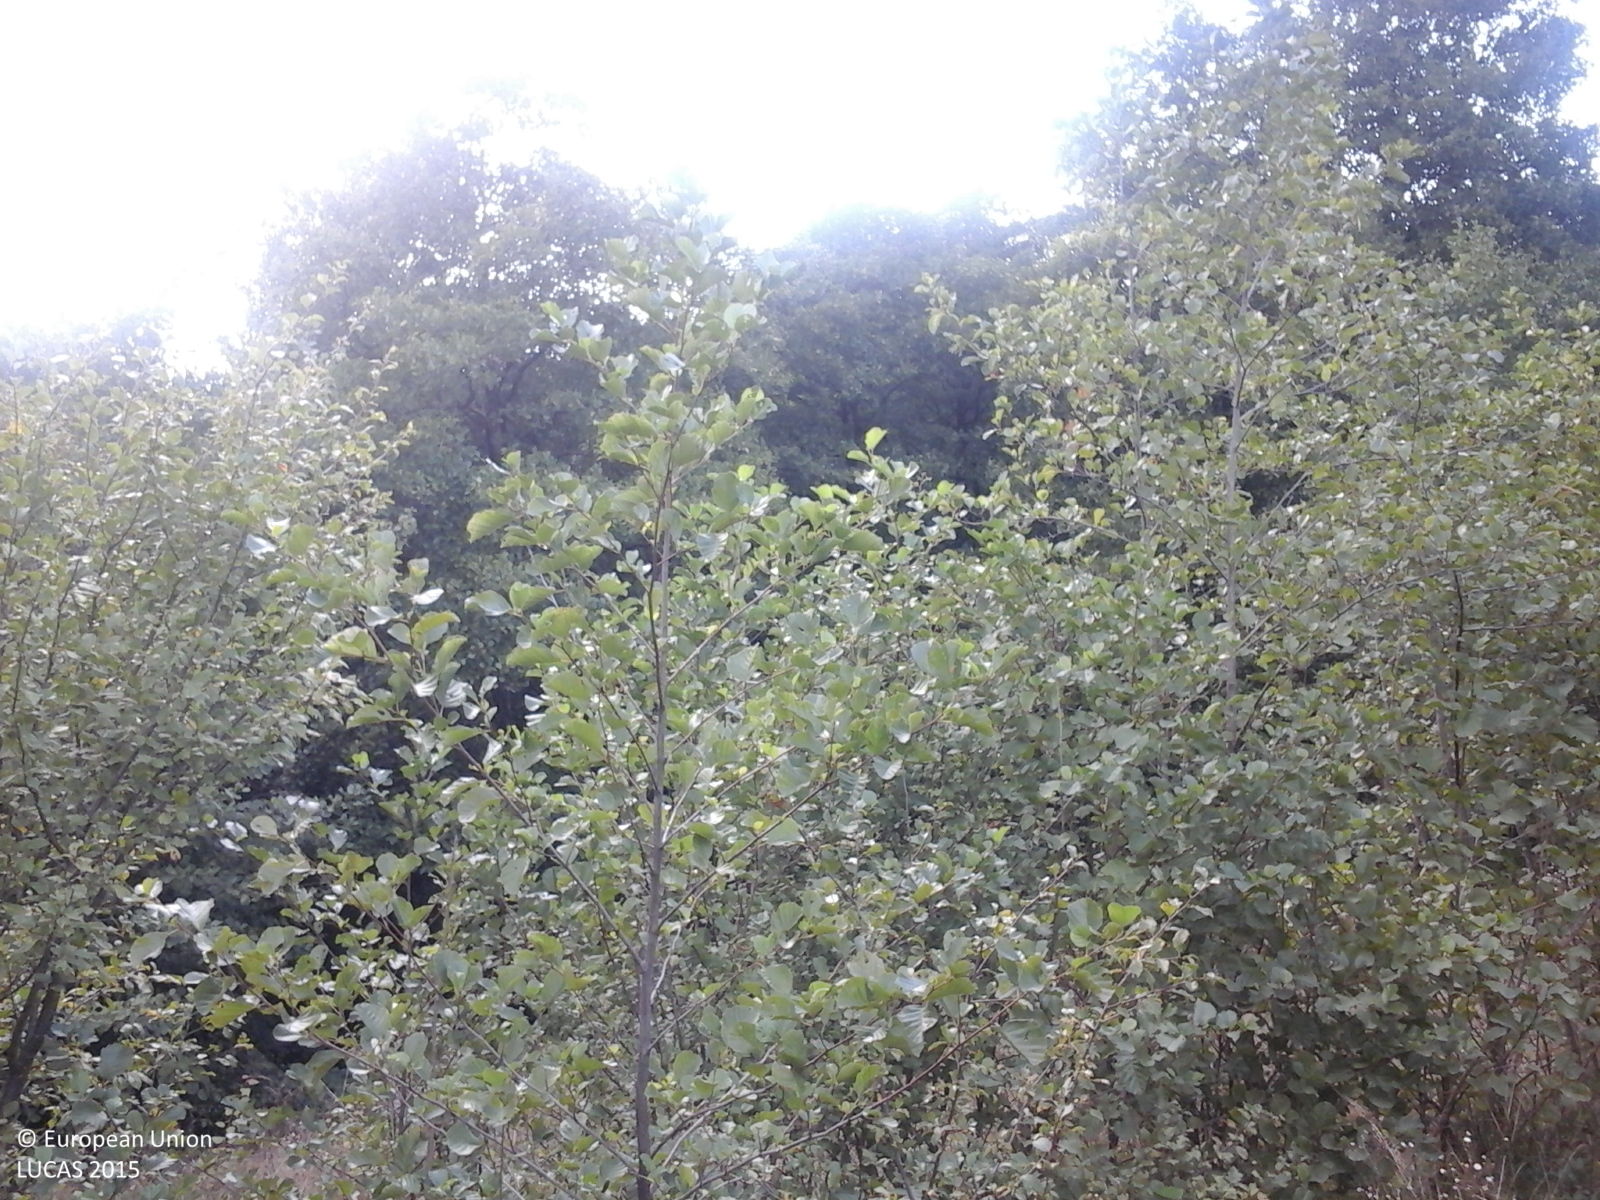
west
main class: Grassland
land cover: Grassland with sparse tree/shrub cover
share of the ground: > 75 %
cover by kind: herbaceous plants 85 %, shrubs 10 %, broadleaved forest trees 5 %
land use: Agriculture (excluding fallow land and kitchen gardens)
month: September
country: RO
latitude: 46.9296
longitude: 22.6250
